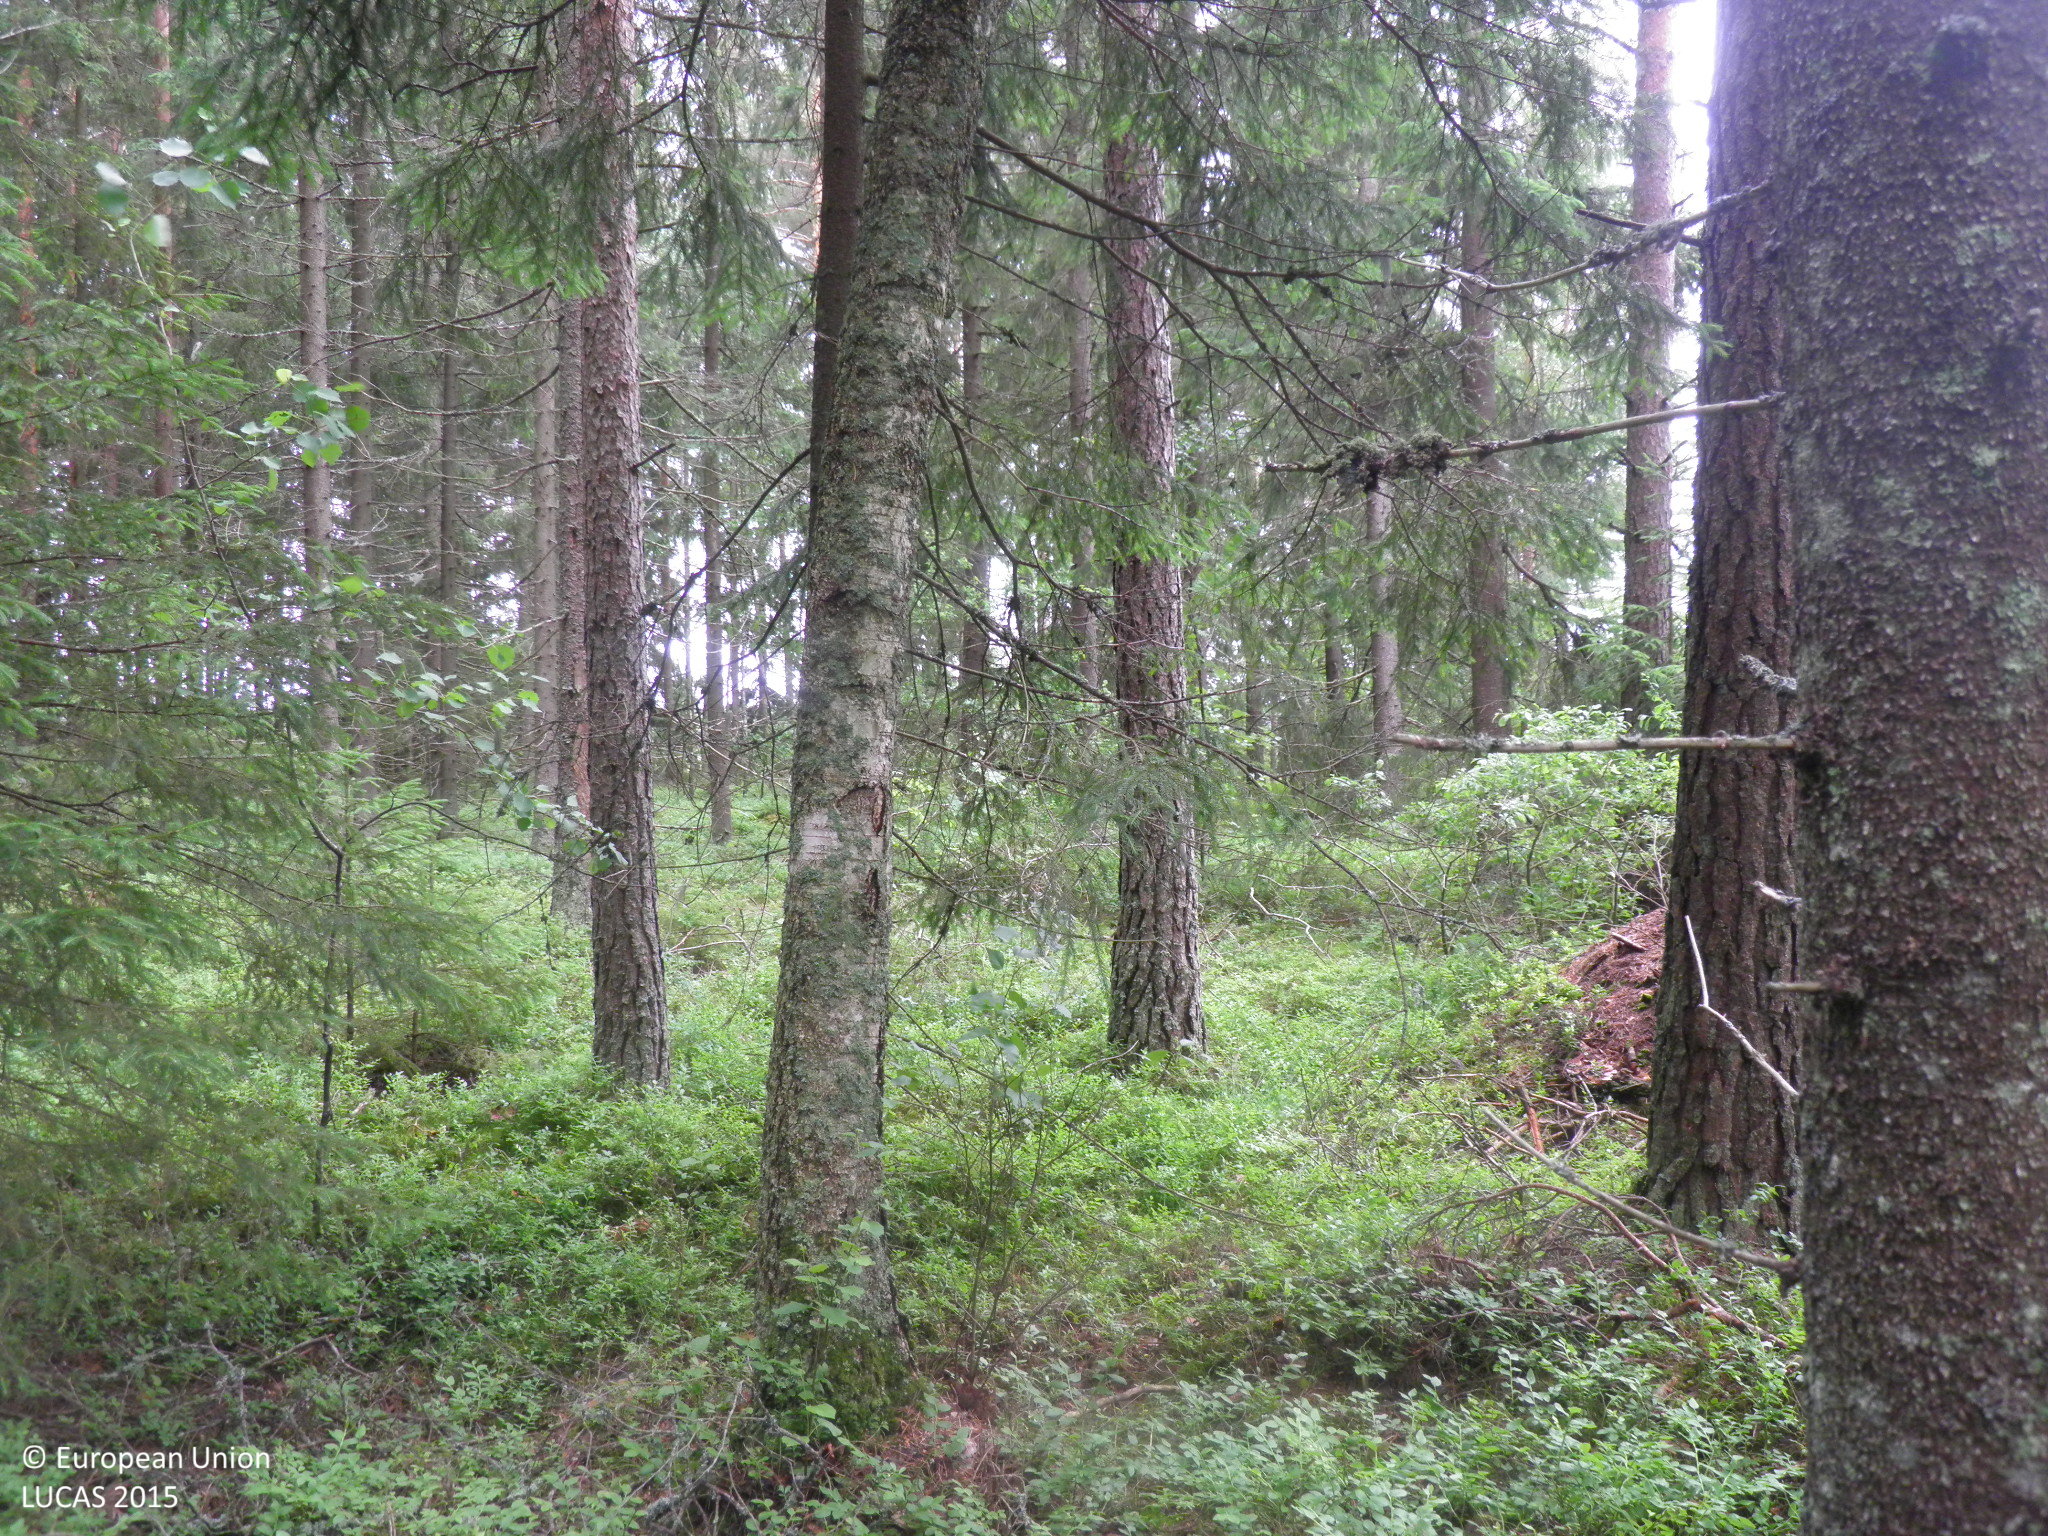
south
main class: Woodland
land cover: Spruce dominated coniferous woodland
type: boreal forest
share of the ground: > 75 %
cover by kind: coniferous forest trees 60 %, broadleaved forest trees 15 %, shrubs 15 %, lichens and mosses 10 %
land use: Forestry
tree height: > 5 m
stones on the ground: < 10 %
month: July
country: FI
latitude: 60.7054
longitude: 22.8442
